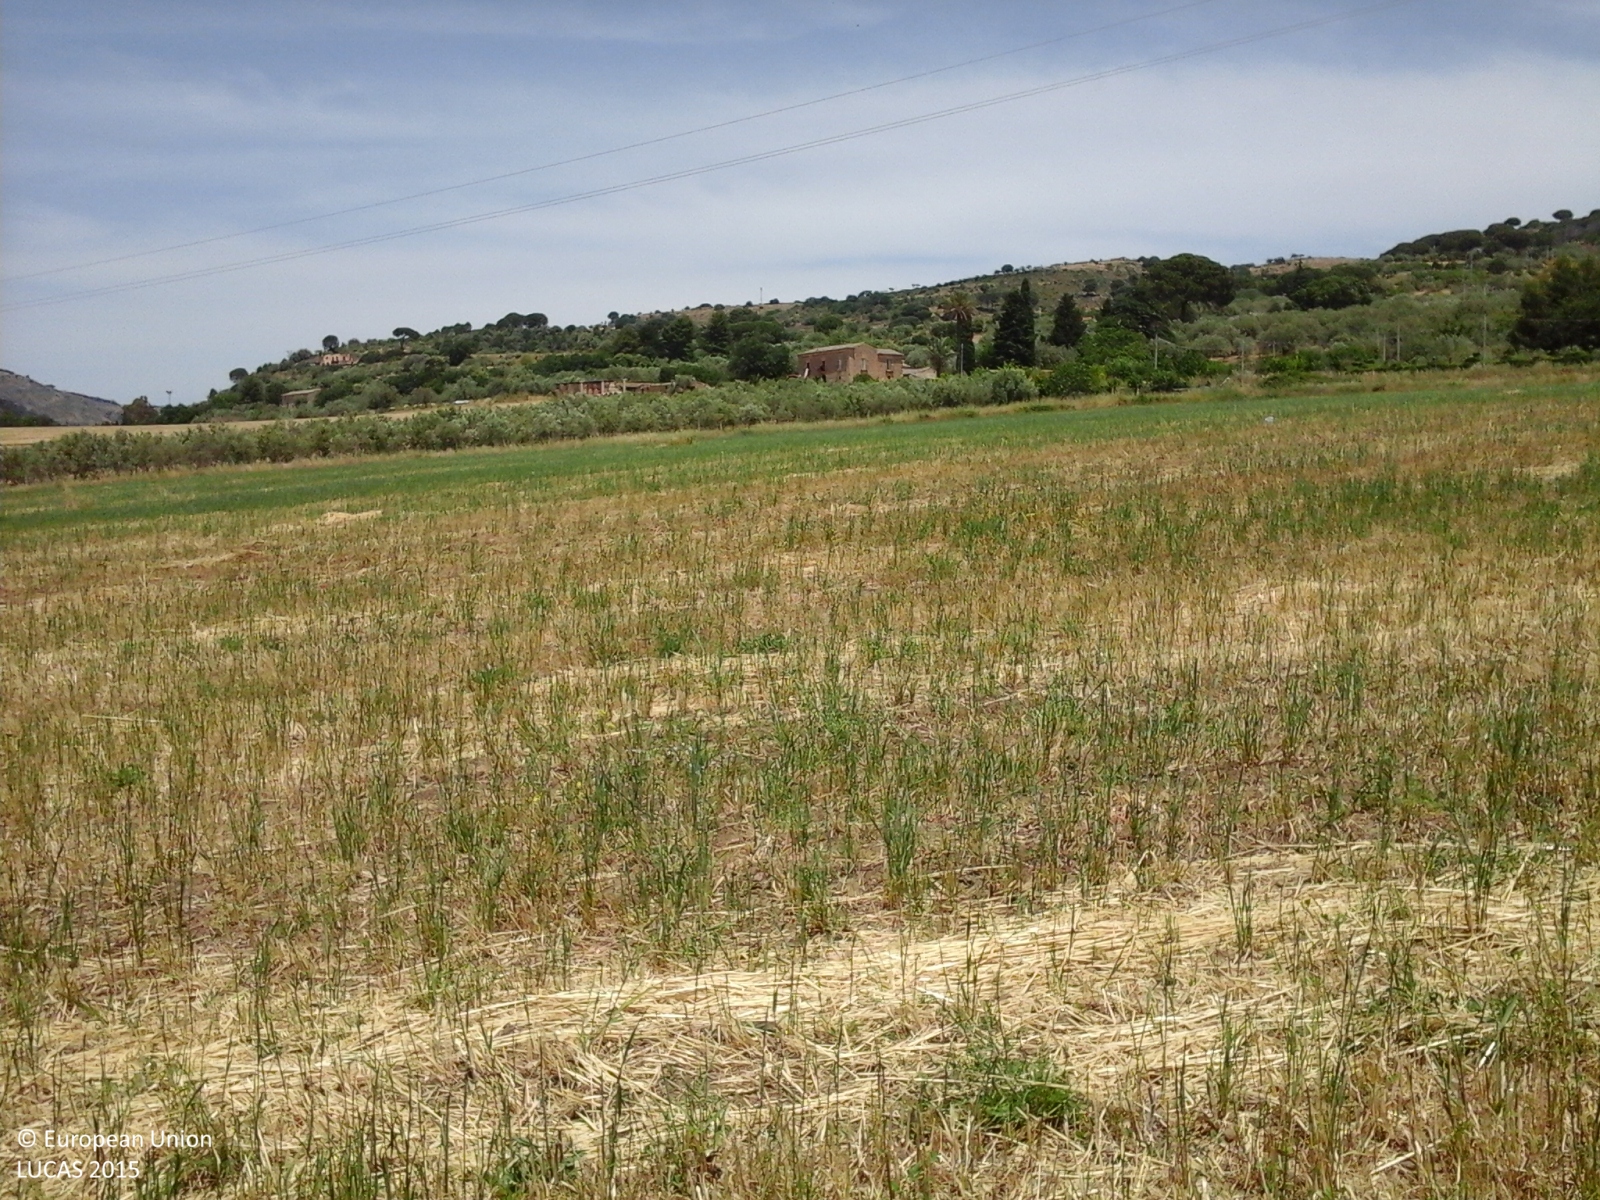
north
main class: Cropland
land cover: Other leguminous and mixtures for fodder
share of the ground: > 75 %
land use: Agriculture (excluding fallow land and kitchen gardens)
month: May
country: IT
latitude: 37.3577
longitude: 14.3365
